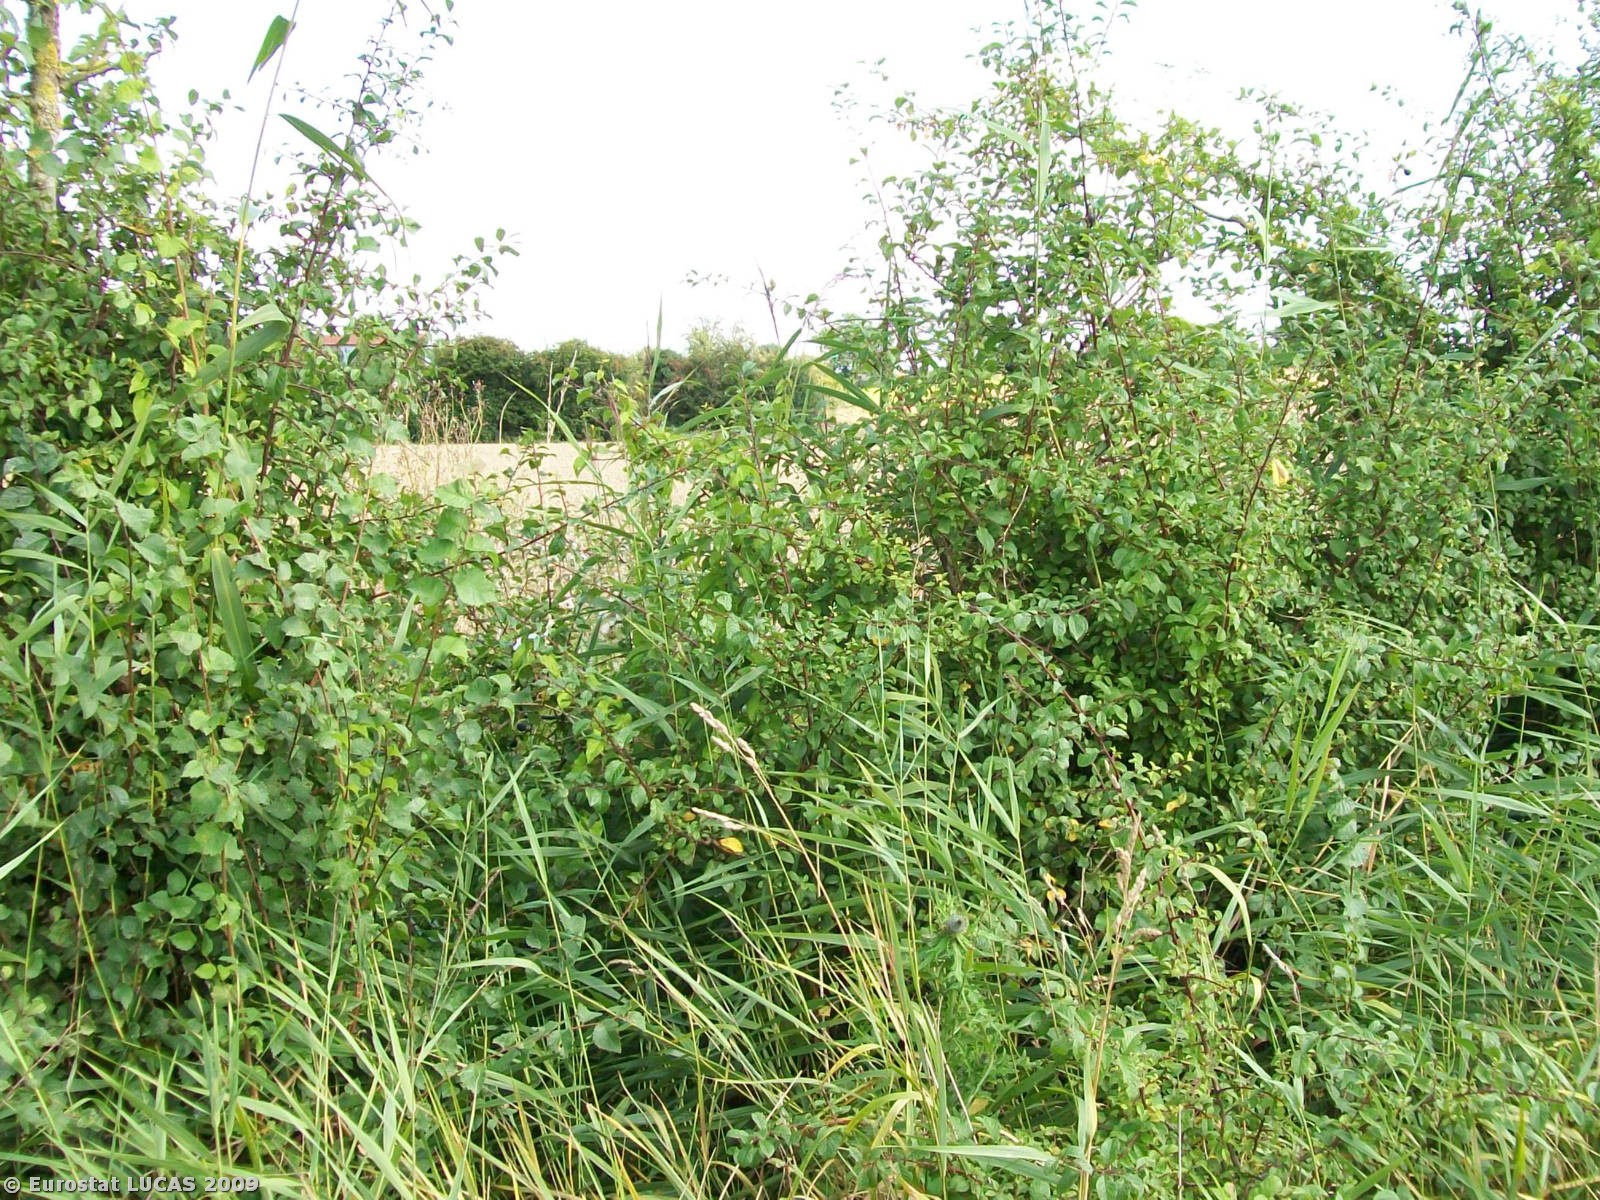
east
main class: Cropland
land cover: Common wheat
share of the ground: > 75 %
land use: Agriculture (excluding fallow land and kitchen gardens)
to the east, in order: Common wheat; Grass margins; Abandoned hedges; Ditches and canals; Grass margins; Common wheat; Grass margins; Managed hedges; Artificial constructions; Apple fruit; Abandoned hedges; Grassland without tree/shrub cover
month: August
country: GB
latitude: 51.8203
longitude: -2.3520
